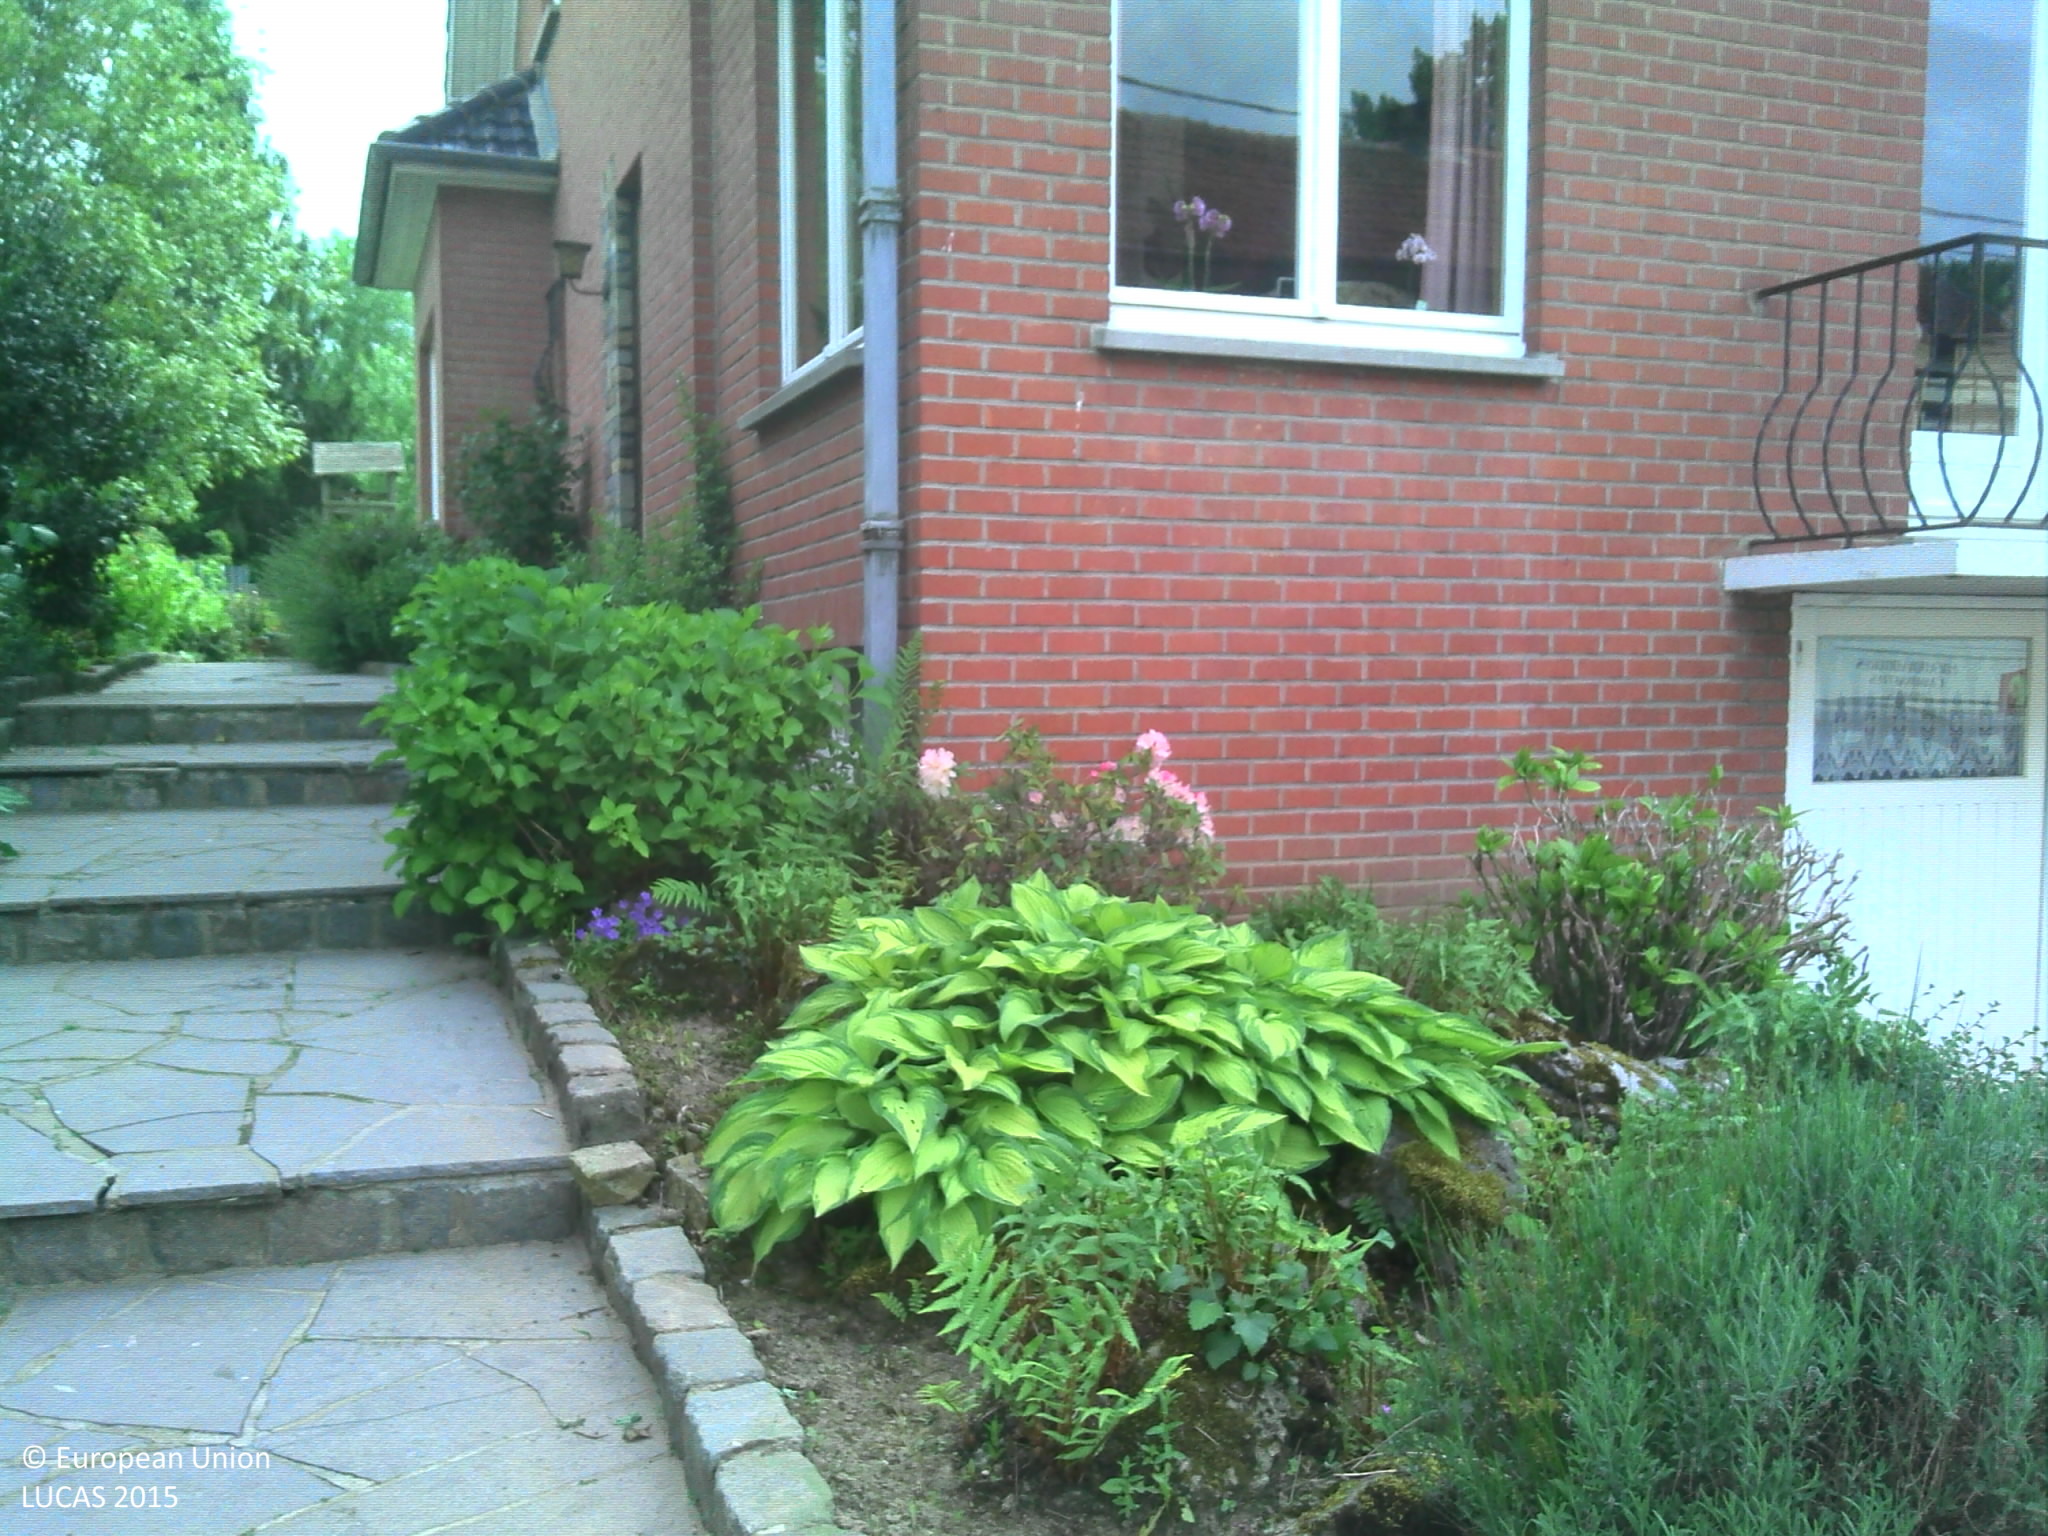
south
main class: Grassland
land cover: Grassland with sparse tree/shrub cover
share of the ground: > 75 %
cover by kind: herbaceous plants 95 %, broadleaved forest trees 5 %
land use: Residential
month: May
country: BE
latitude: 50.7808
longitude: 4.6777
